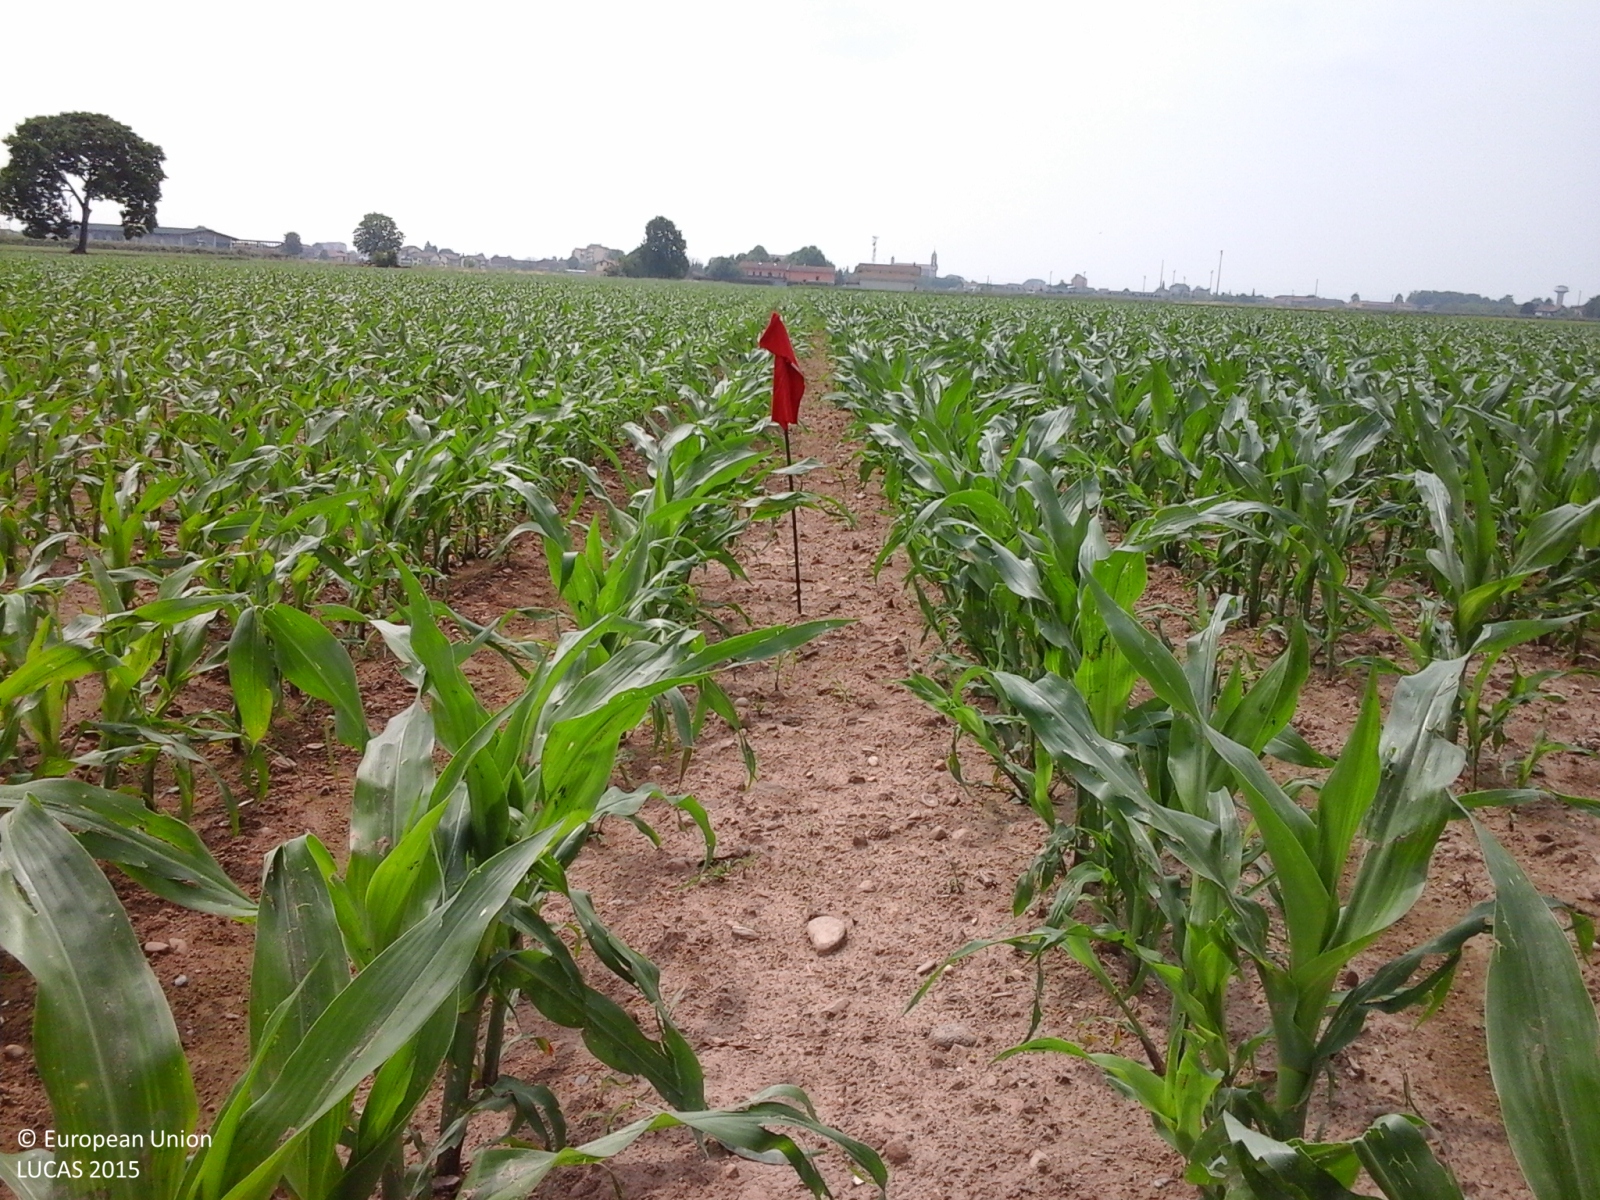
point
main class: Cropland
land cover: Maize
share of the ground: 50 - 75 %
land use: Agriculture (excluding fallow land and kitchen gardens)
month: May
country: IT
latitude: 45.3237
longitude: 8.0258
